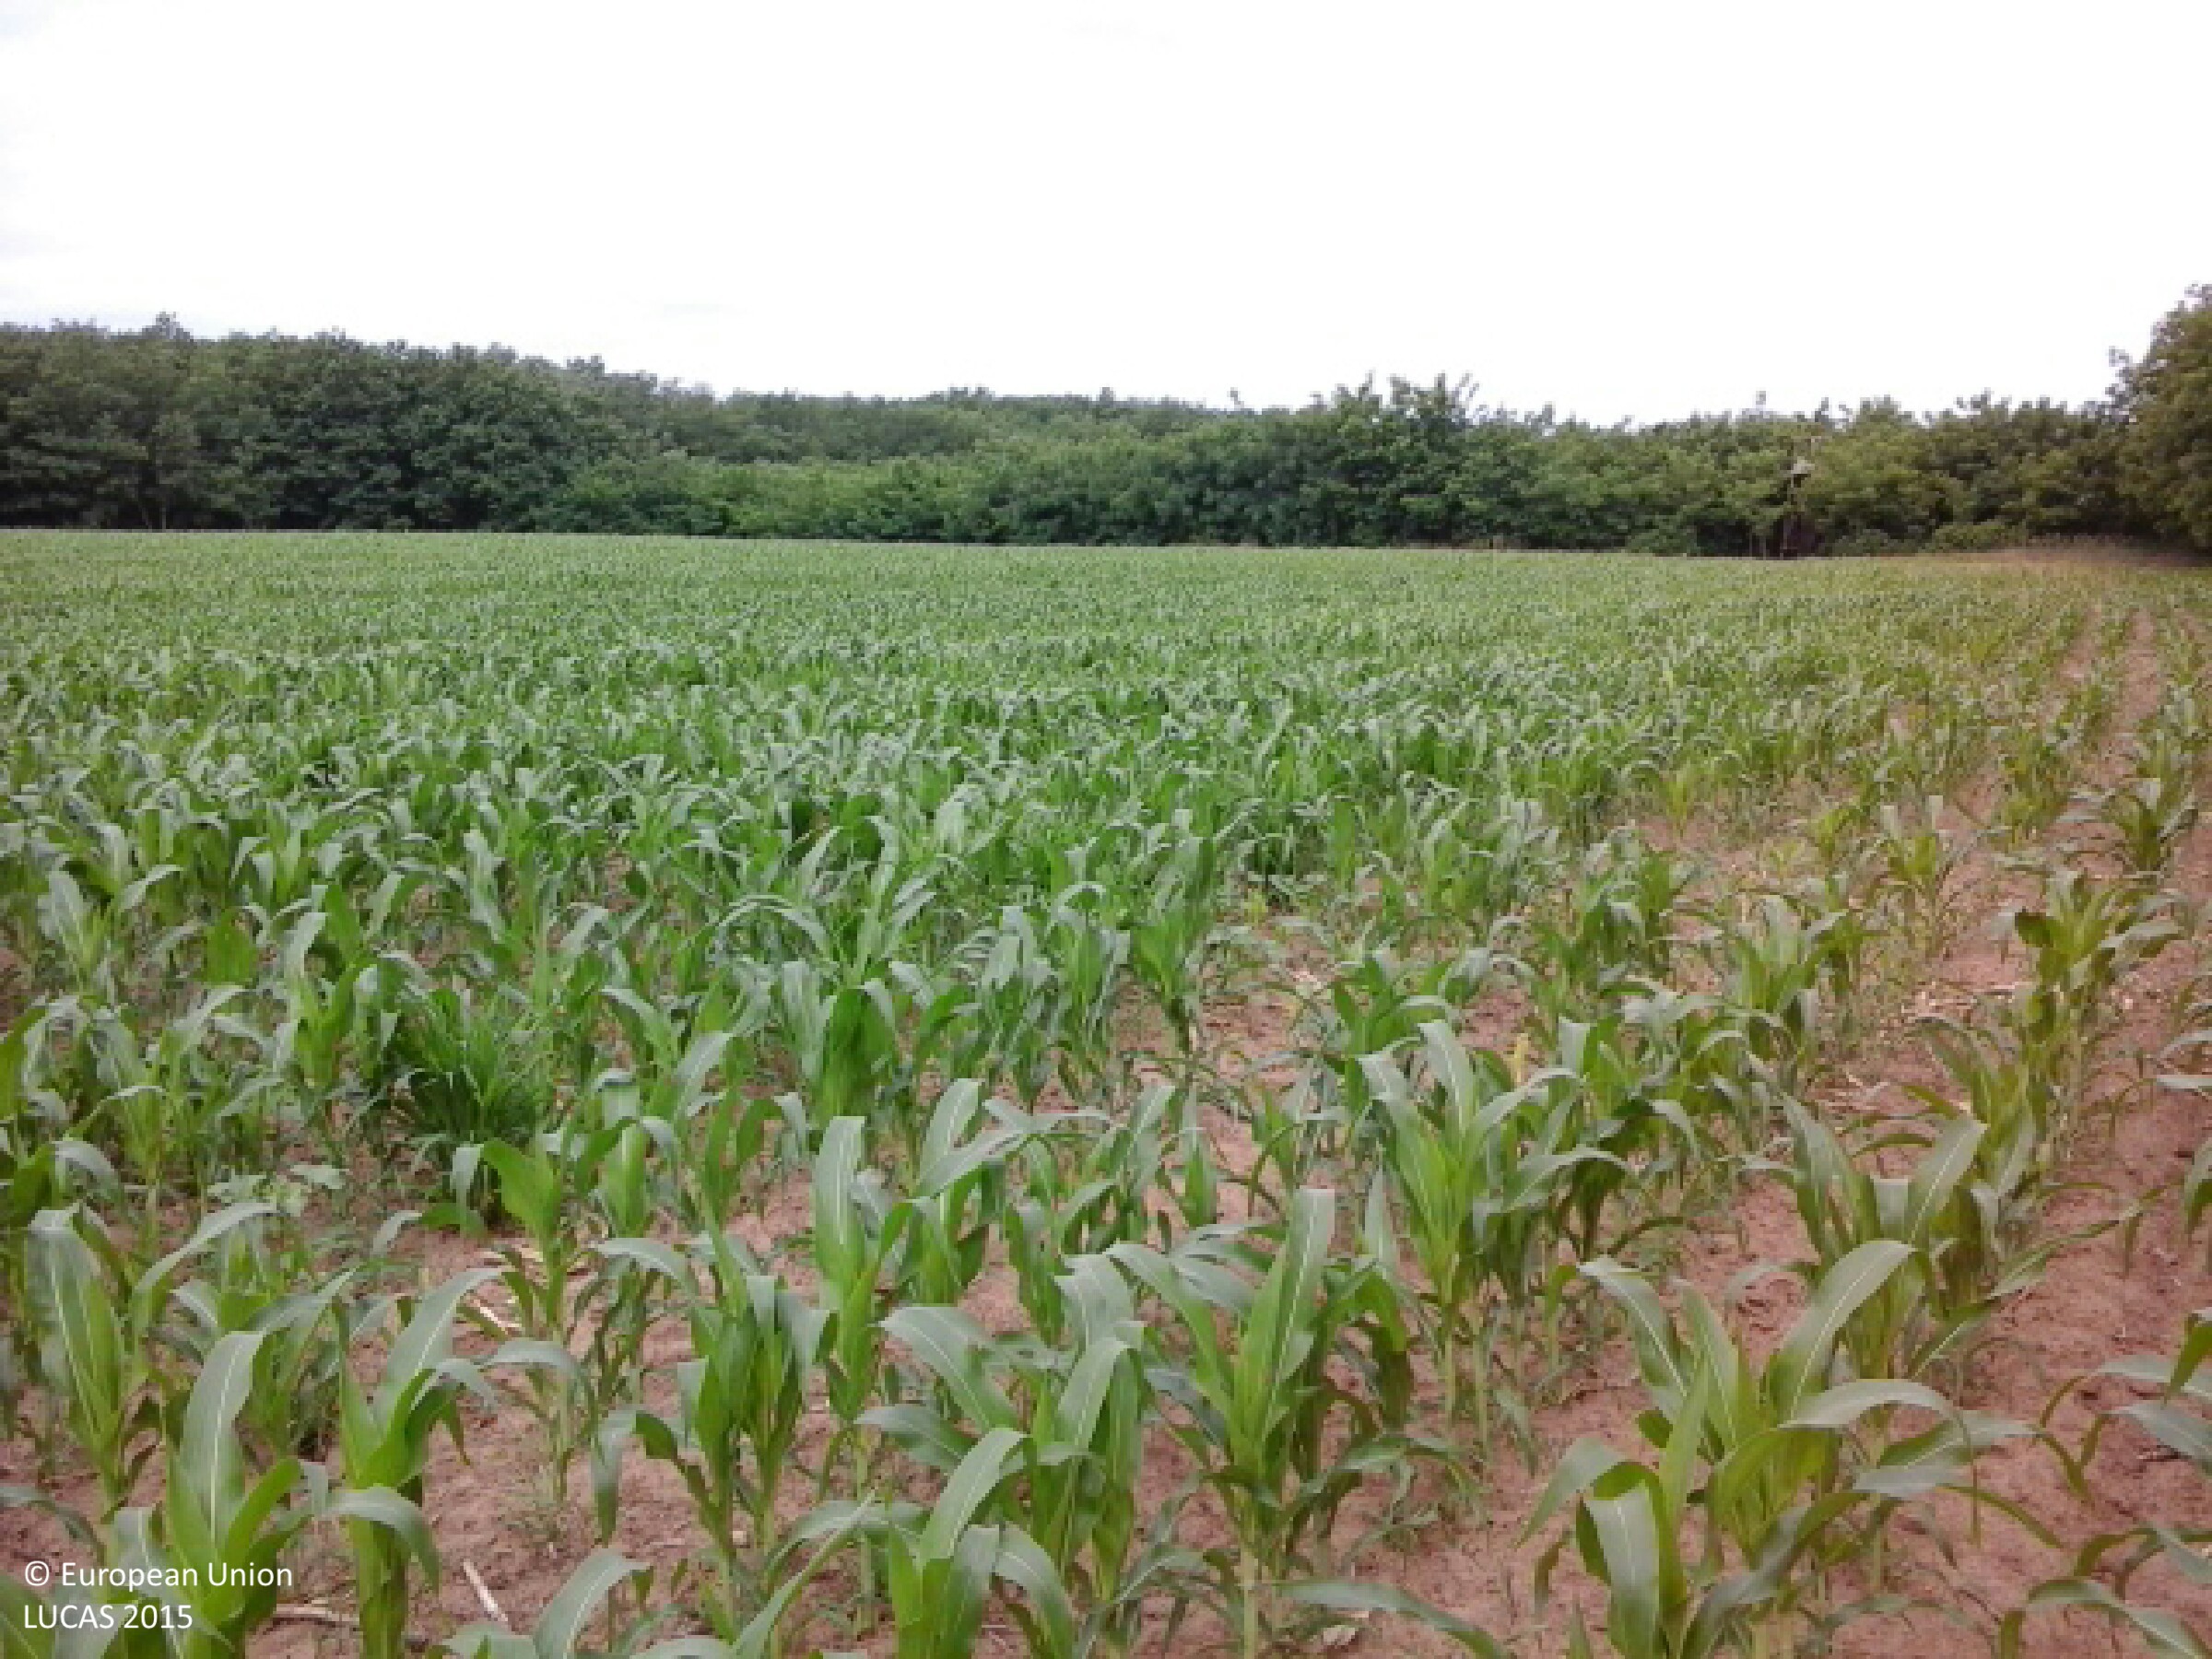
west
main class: Cropland
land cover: Maize
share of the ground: 10 - 25 %
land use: Agriculture (excluding fallow land and kitchen gardens)
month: June
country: HU
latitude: 48.0079
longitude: 21.7780
